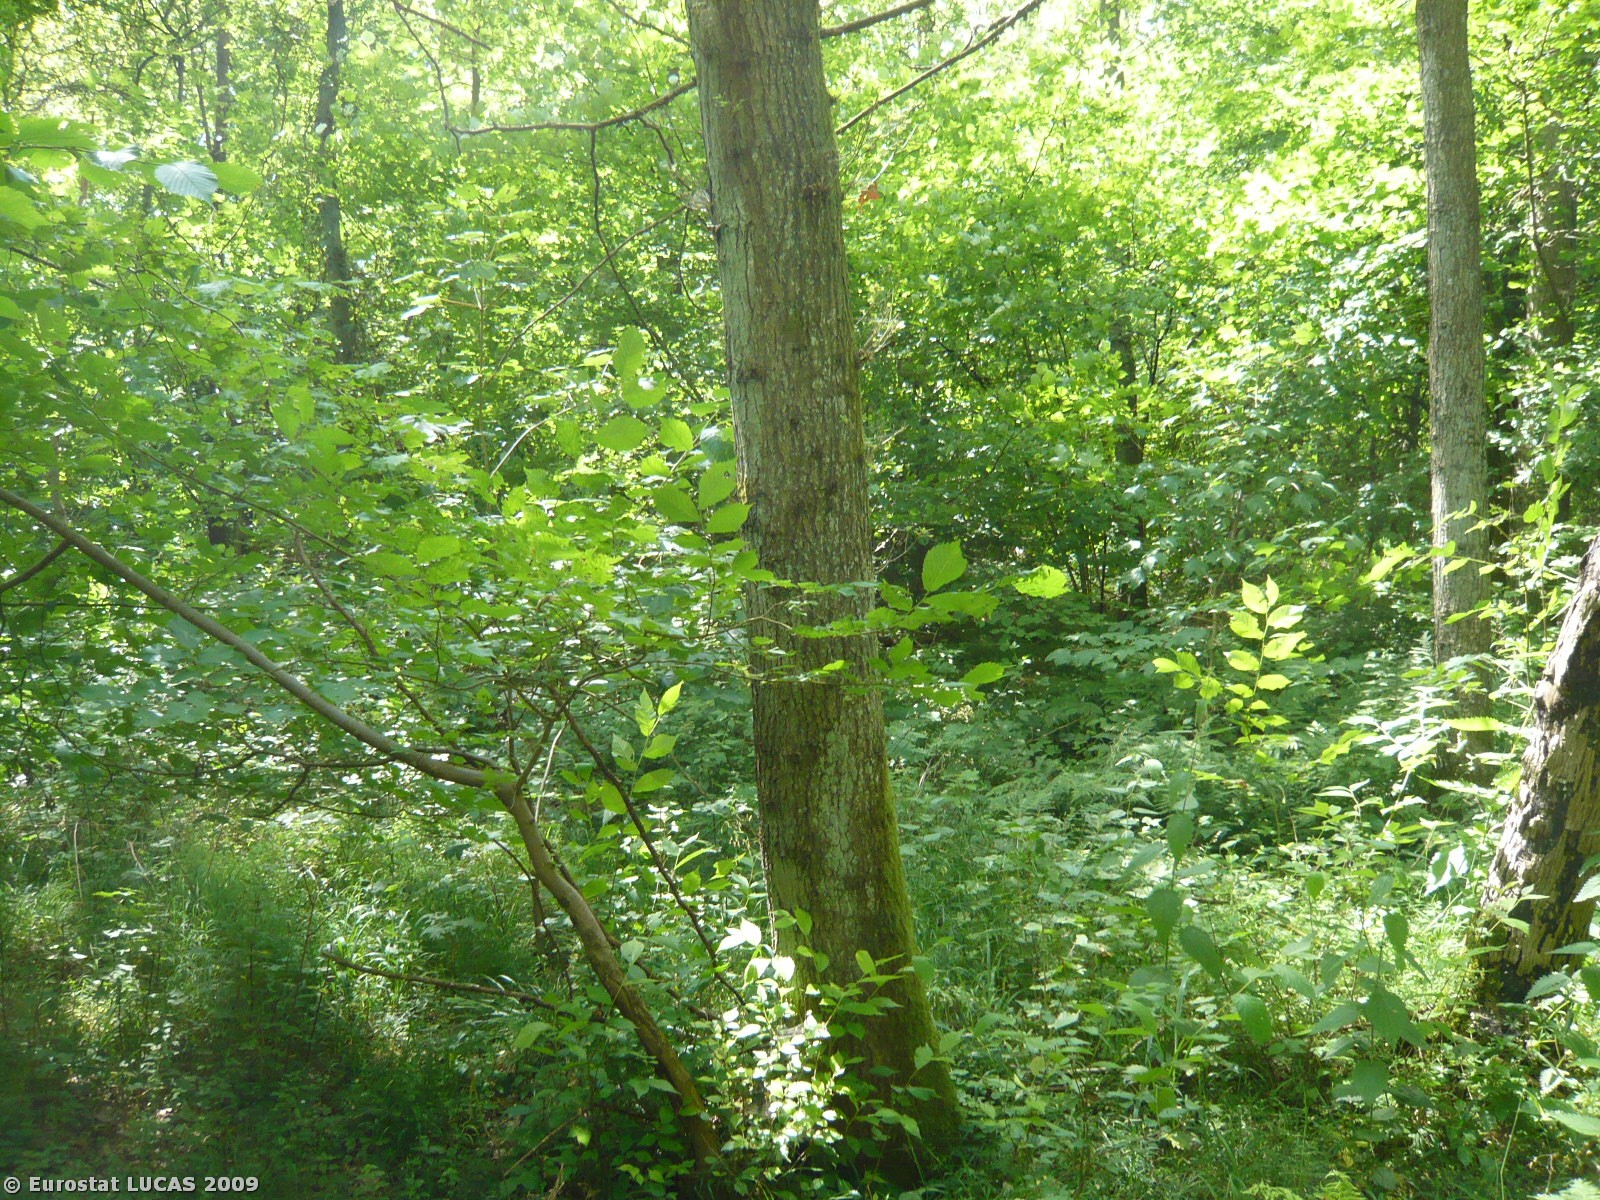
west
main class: Woodland
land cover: Broadleaved woodland
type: mesophytic deciduous forest
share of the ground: > 75 %
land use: Amenities, museums, leisure
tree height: > 5 m
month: June
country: DK
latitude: 55.1450
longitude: 10.2665
